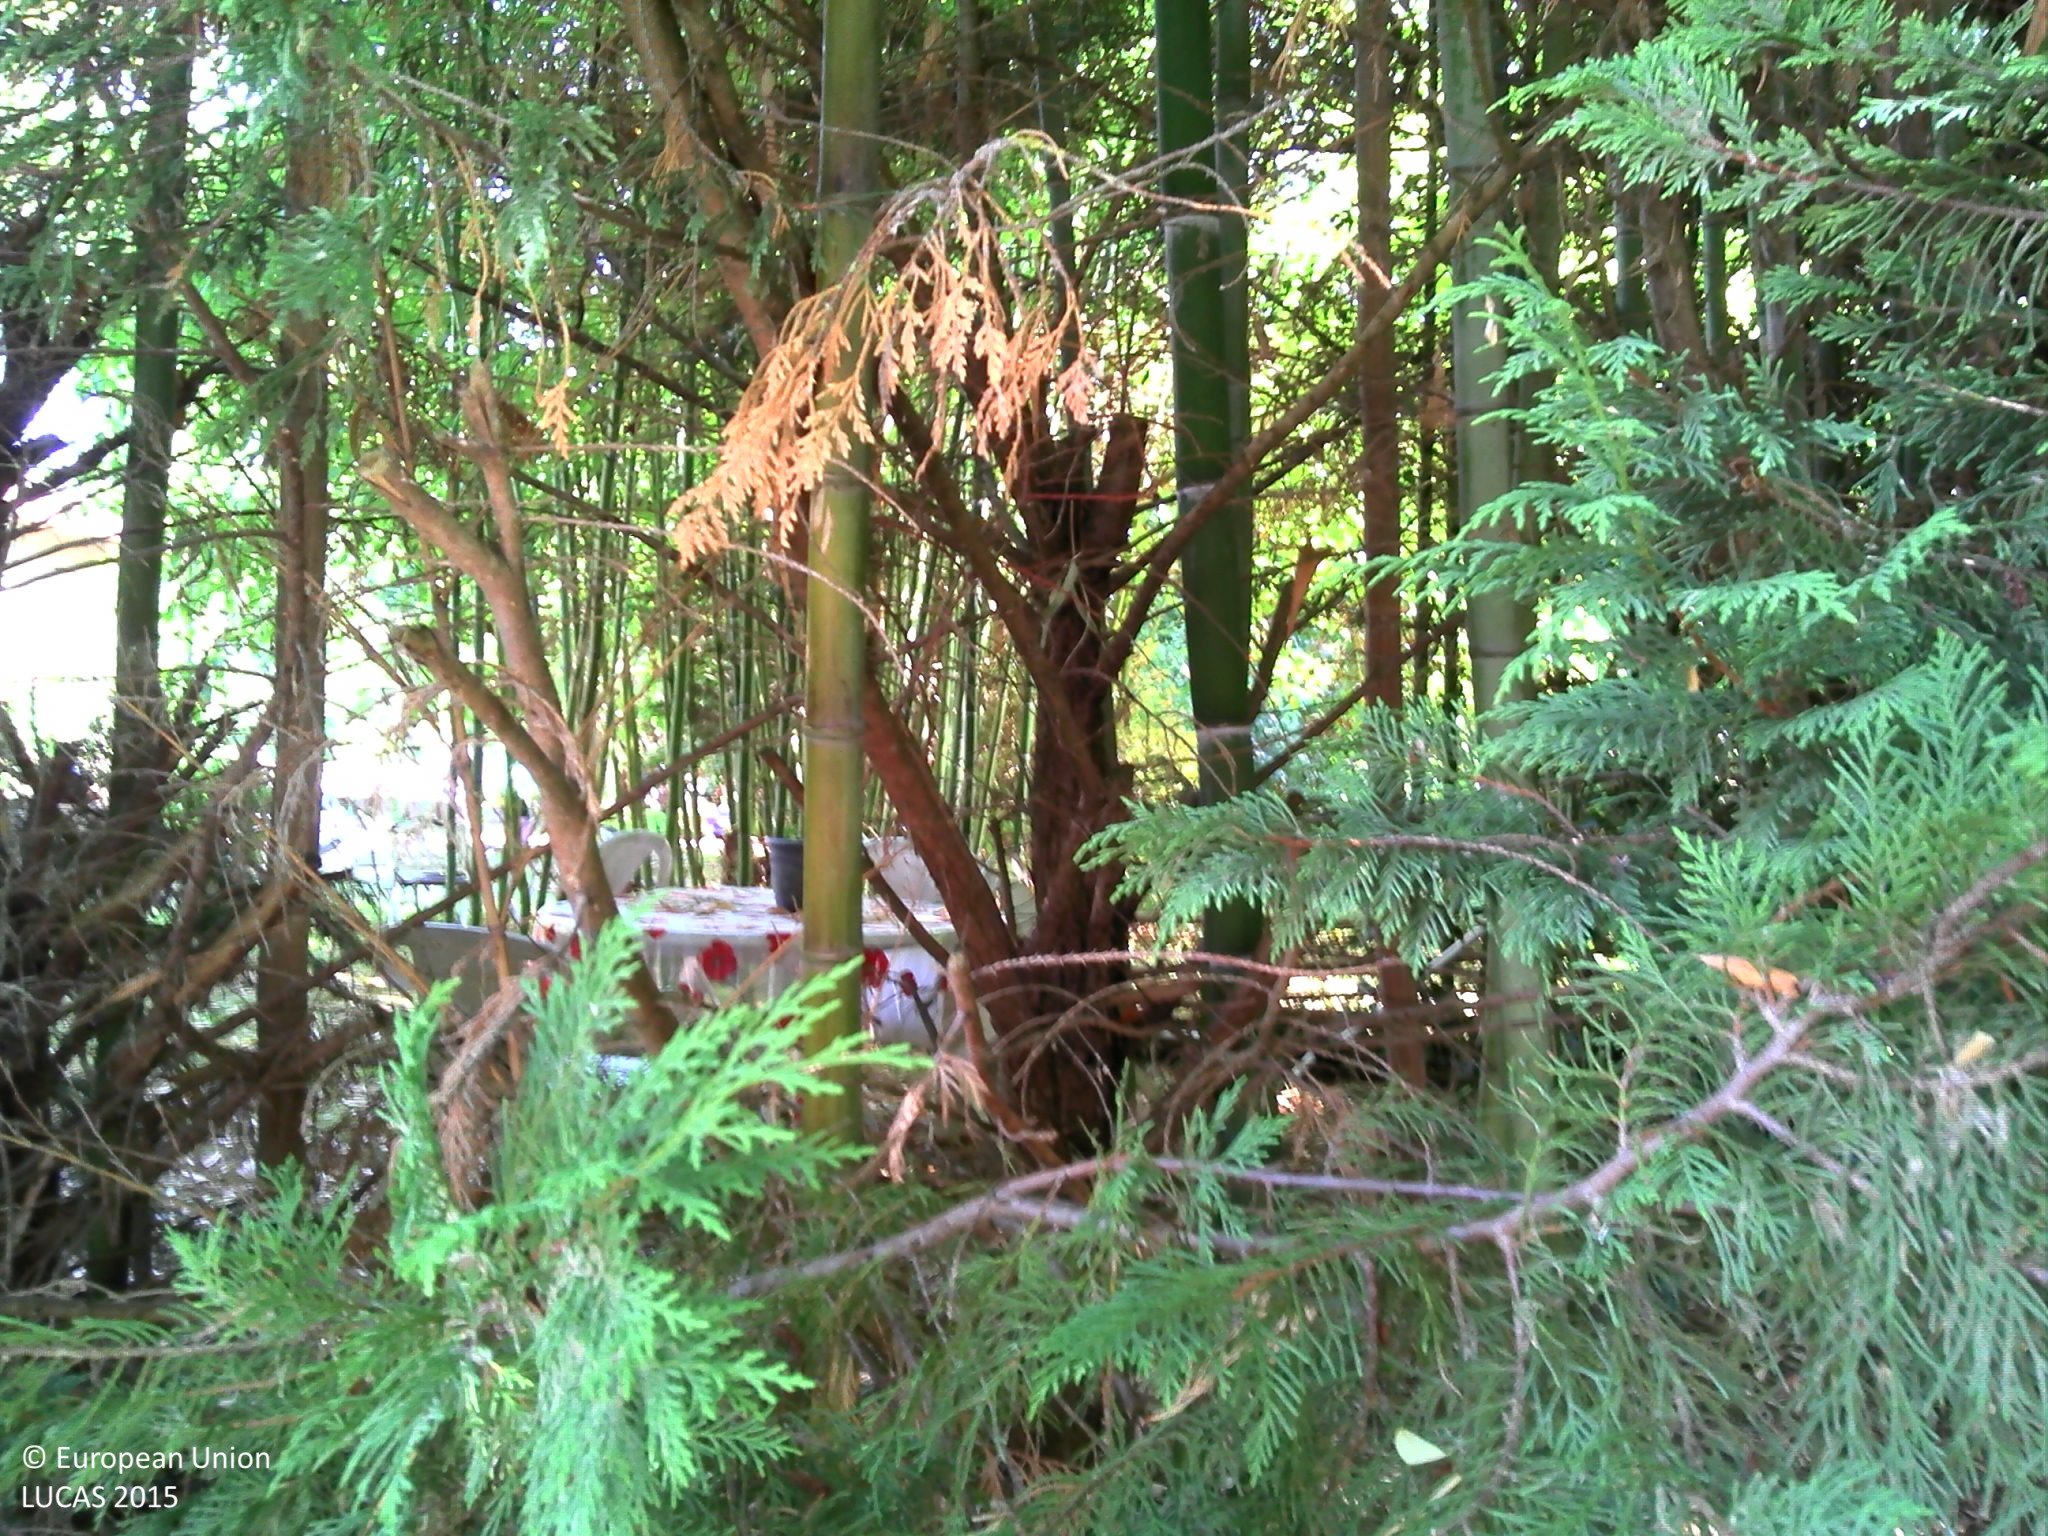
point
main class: Grassland
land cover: Grassland with sparse tree/shrub cover
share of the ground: > 75 %
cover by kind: herbaceous plants 90 %, broadleaved forest trees 5 %, shrubs 5 %
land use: Residential
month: August
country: FR
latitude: 44.1692
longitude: 1.5583
